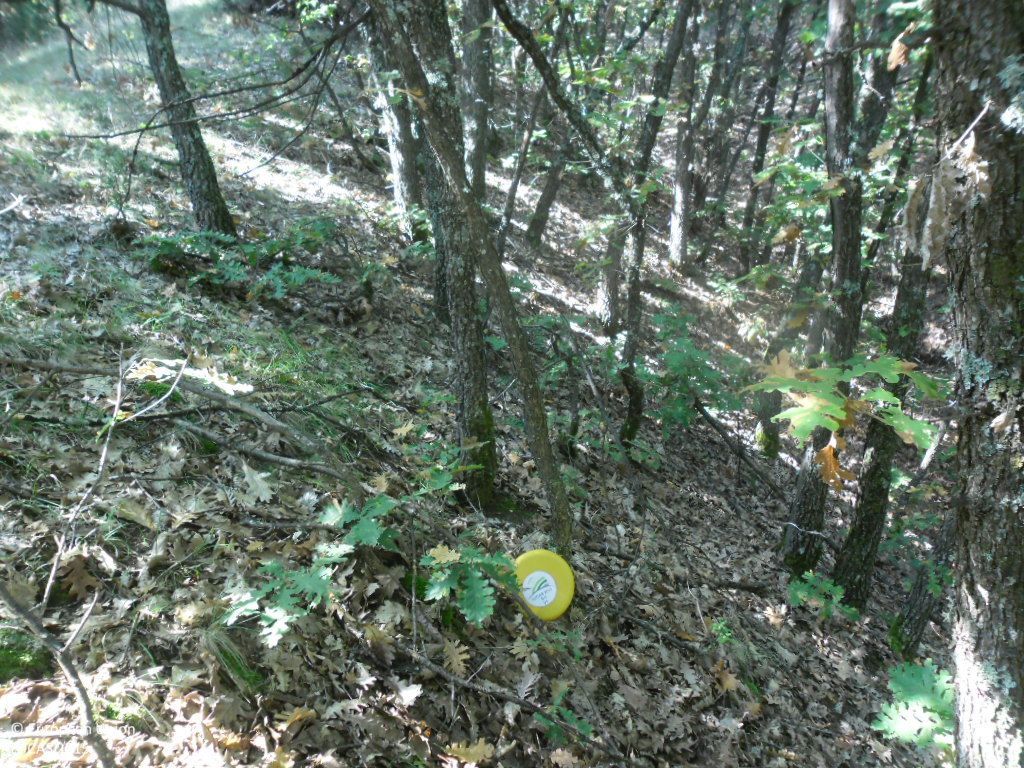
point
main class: Woodland
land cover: Broadleaved woodland
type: mesophytic deciduous forest
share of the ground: > 75 %
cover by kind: broadleaved forest trees 95 %, unconsolidated bare surface 5 %
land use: Forestry
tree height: < 5 m
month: September
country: BG
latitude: 41.9092
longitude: 22.9571
